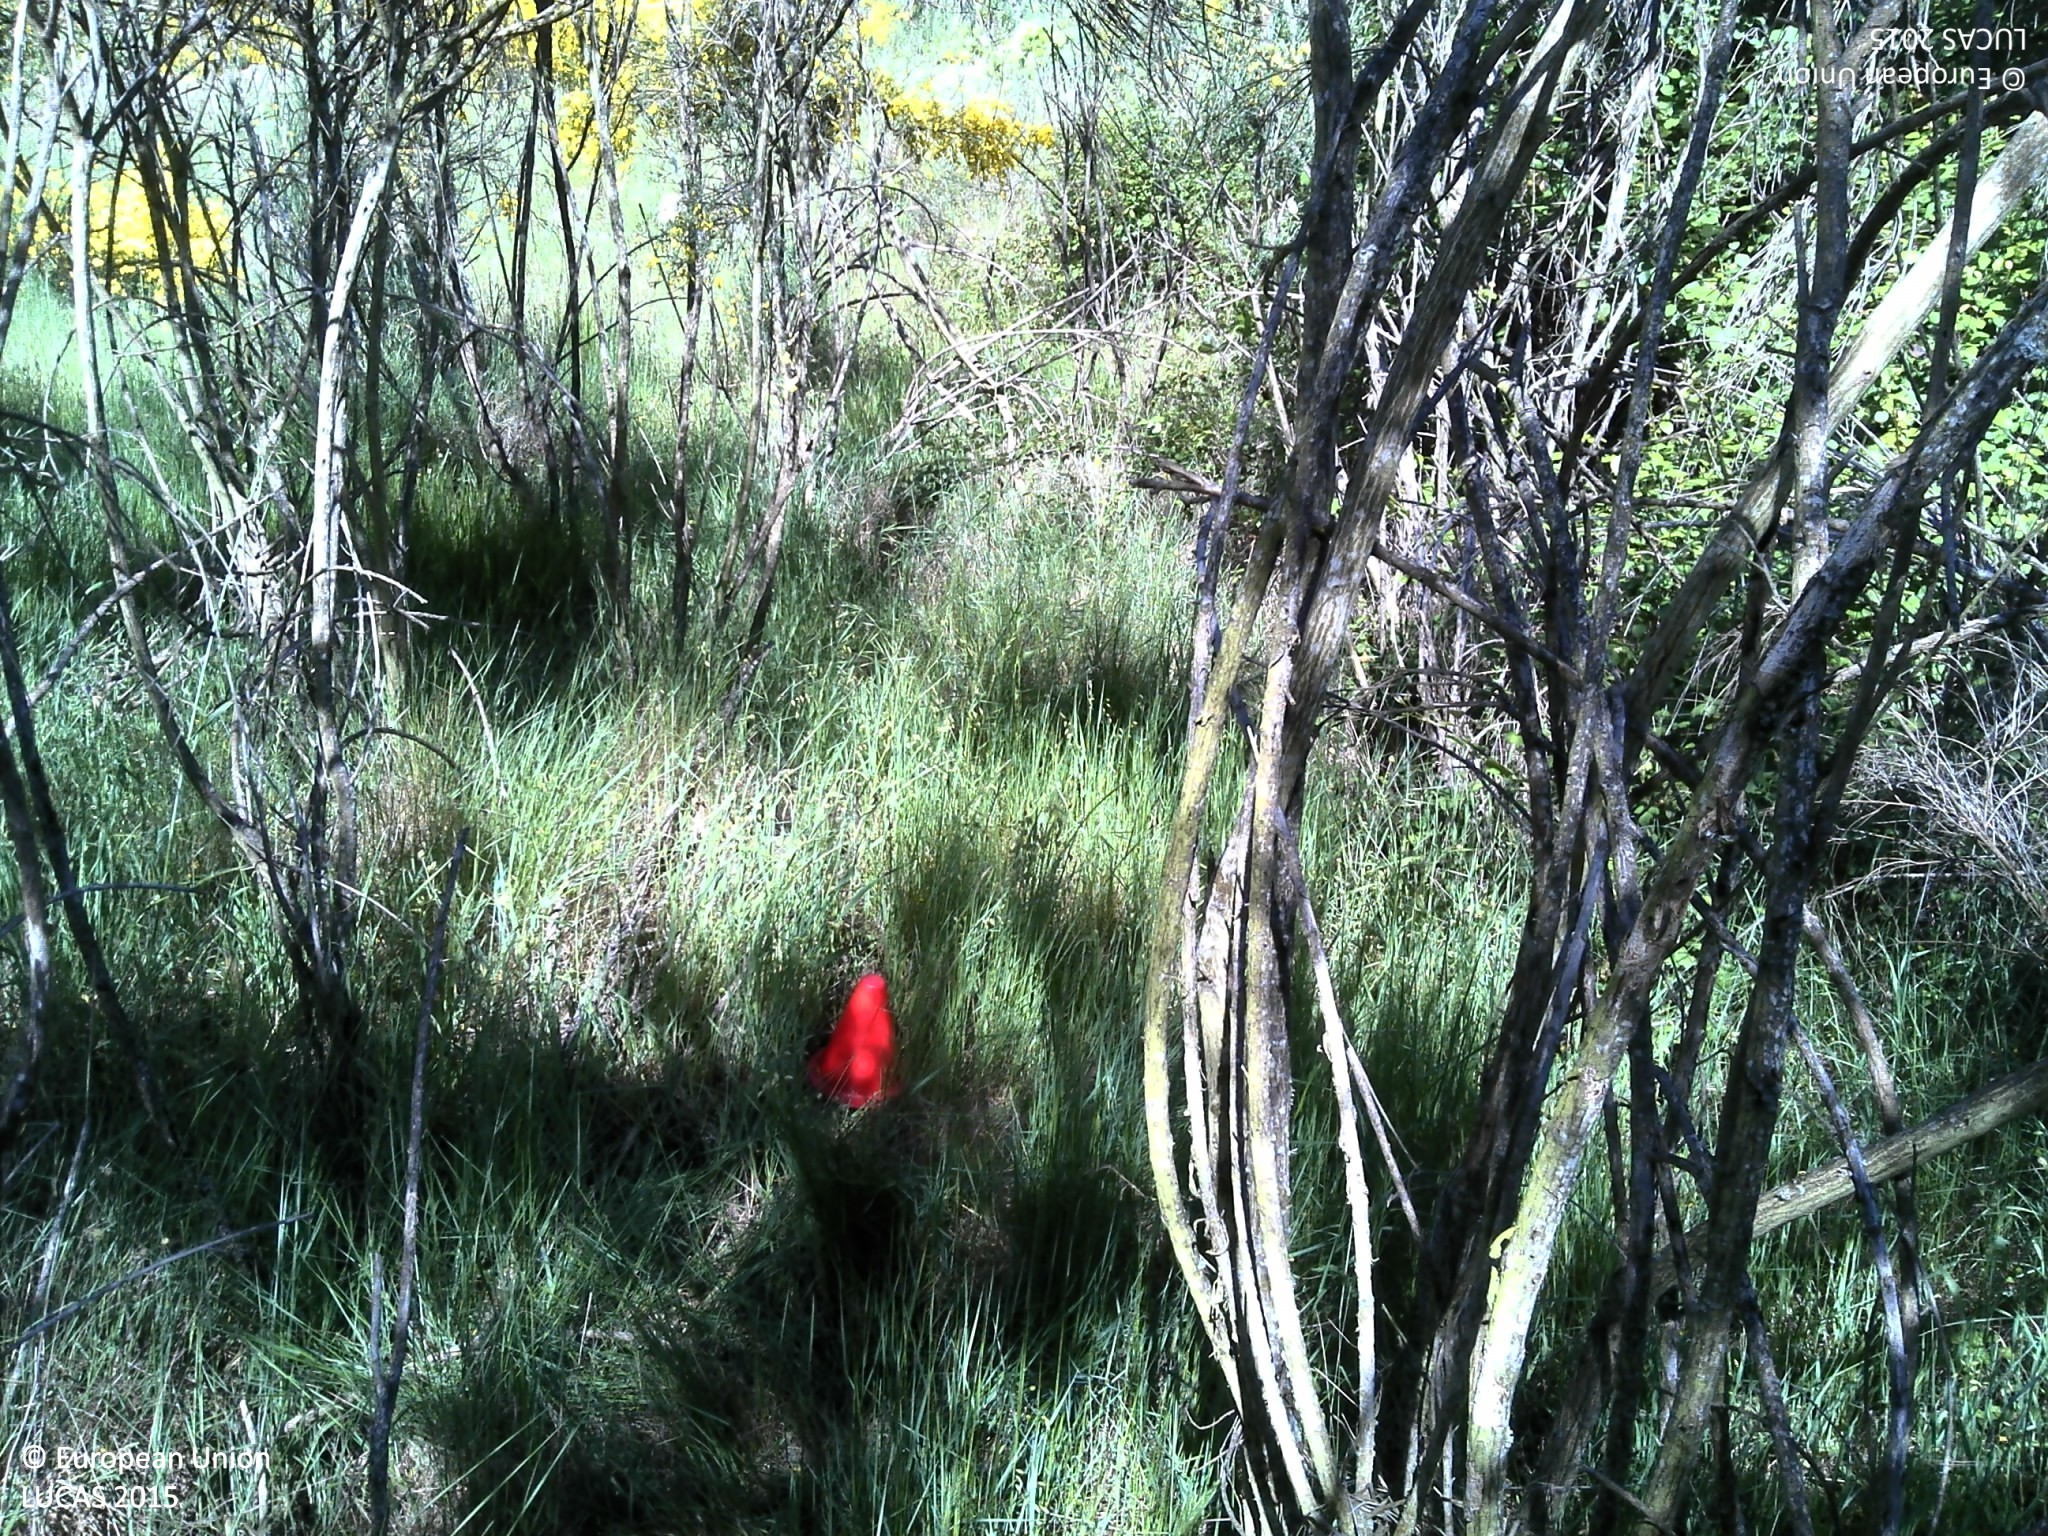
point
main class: Shrubland
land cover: Shrubland without tree cover
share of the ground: 50 - 75 %
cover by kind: shrubs 60 %, herbaceous plants 40 %
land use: Forestry
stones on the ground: < 10 %
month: May
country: PT
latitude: 41.8372
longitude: -7.3858
